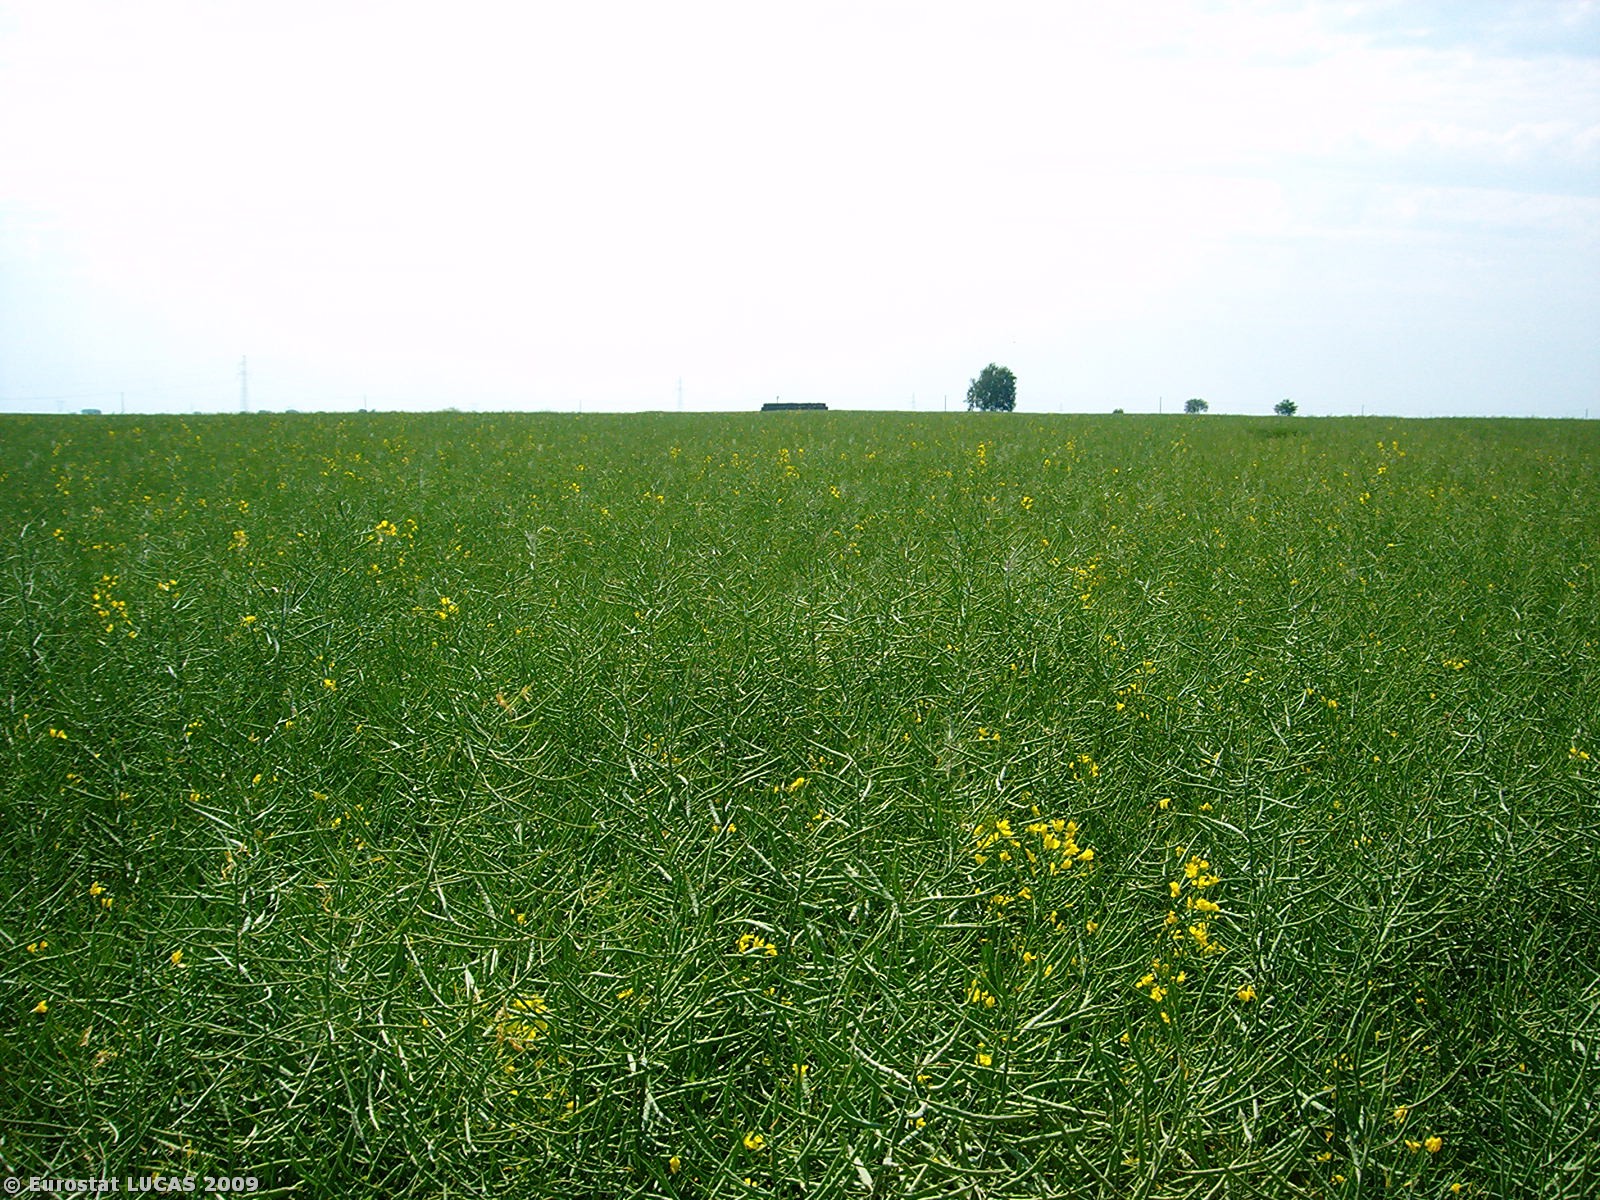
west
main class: Cropland
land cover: Rape and turnip rape
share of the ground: > 75 %
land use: Agriculture (excluding fallow land and kitchen gardens)
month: May
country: PL
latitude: 52.4599
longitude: 16.3501
